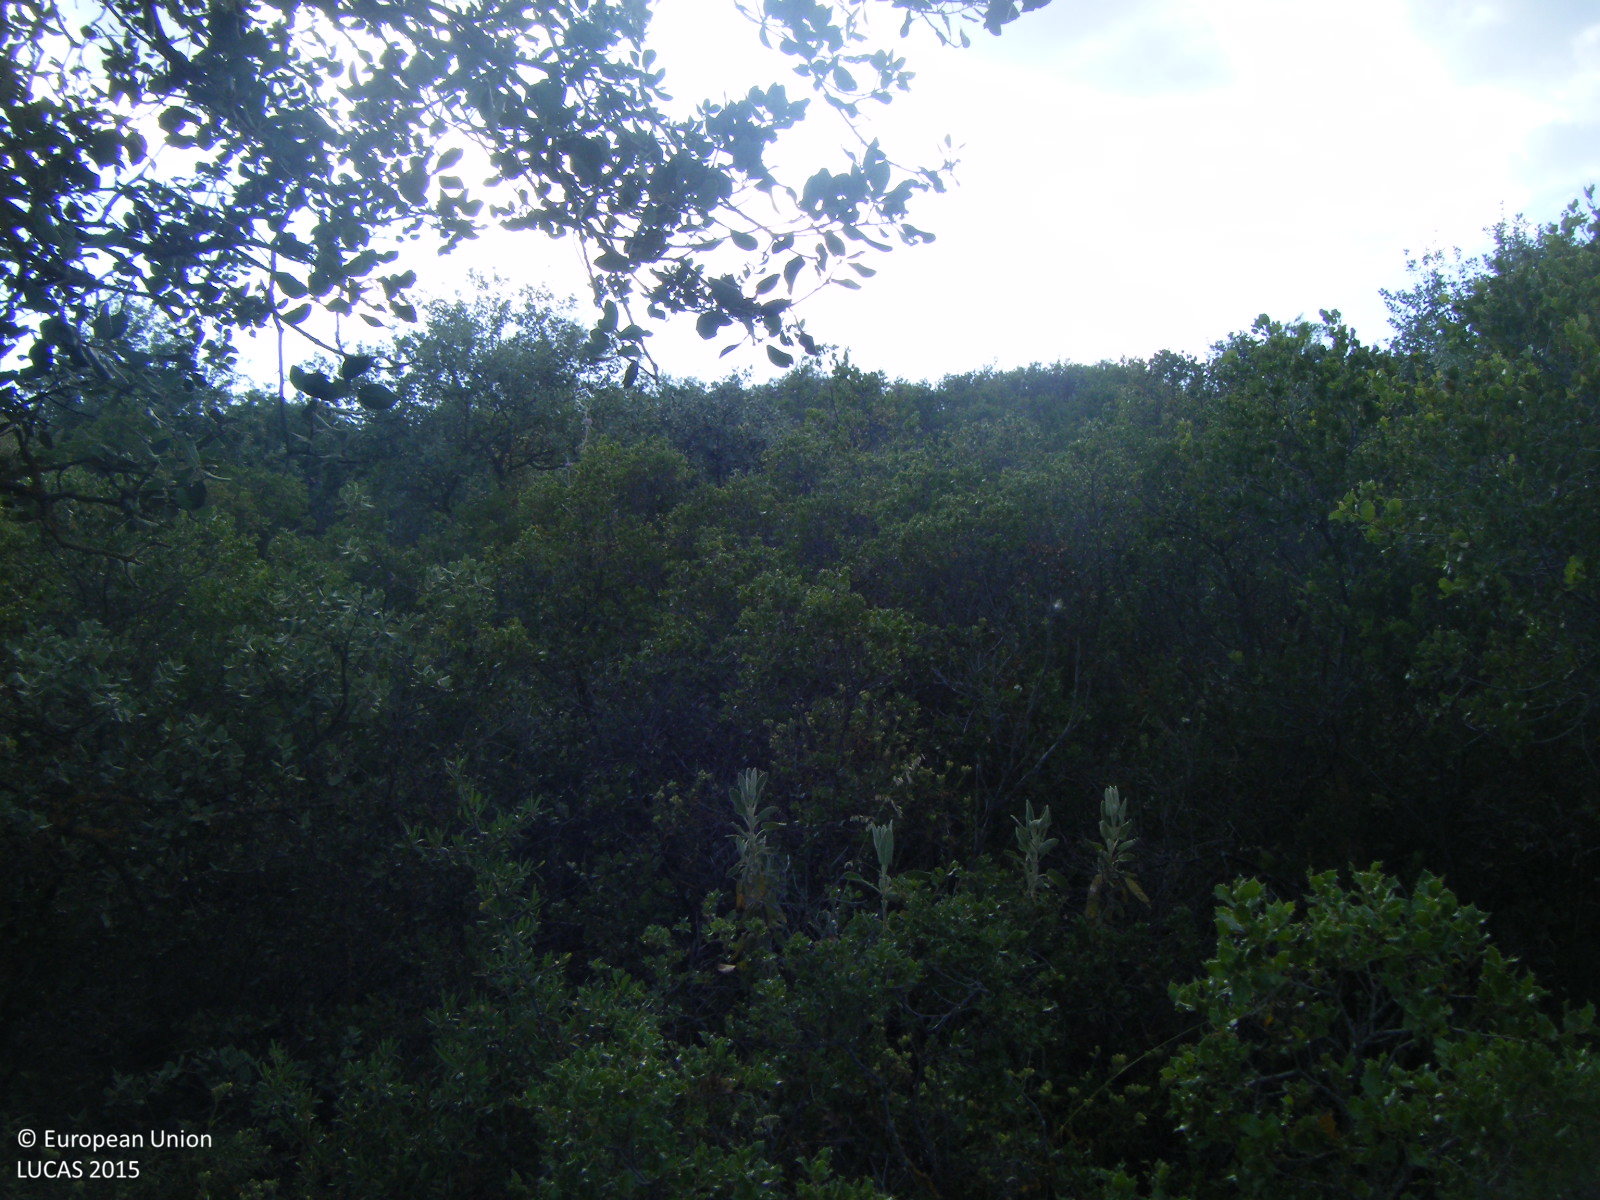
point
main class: Woodland
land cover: Broadleaved woodland
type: broadleaved evergreen forest
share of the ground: 10 - 25 %
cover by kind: shrubs 85 %, broadleaved forest trees 15 %
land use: Semi-natural and natural areas not in use
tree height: < 5 m
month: May
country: ES
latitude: 37.0322
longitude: -4.3957
